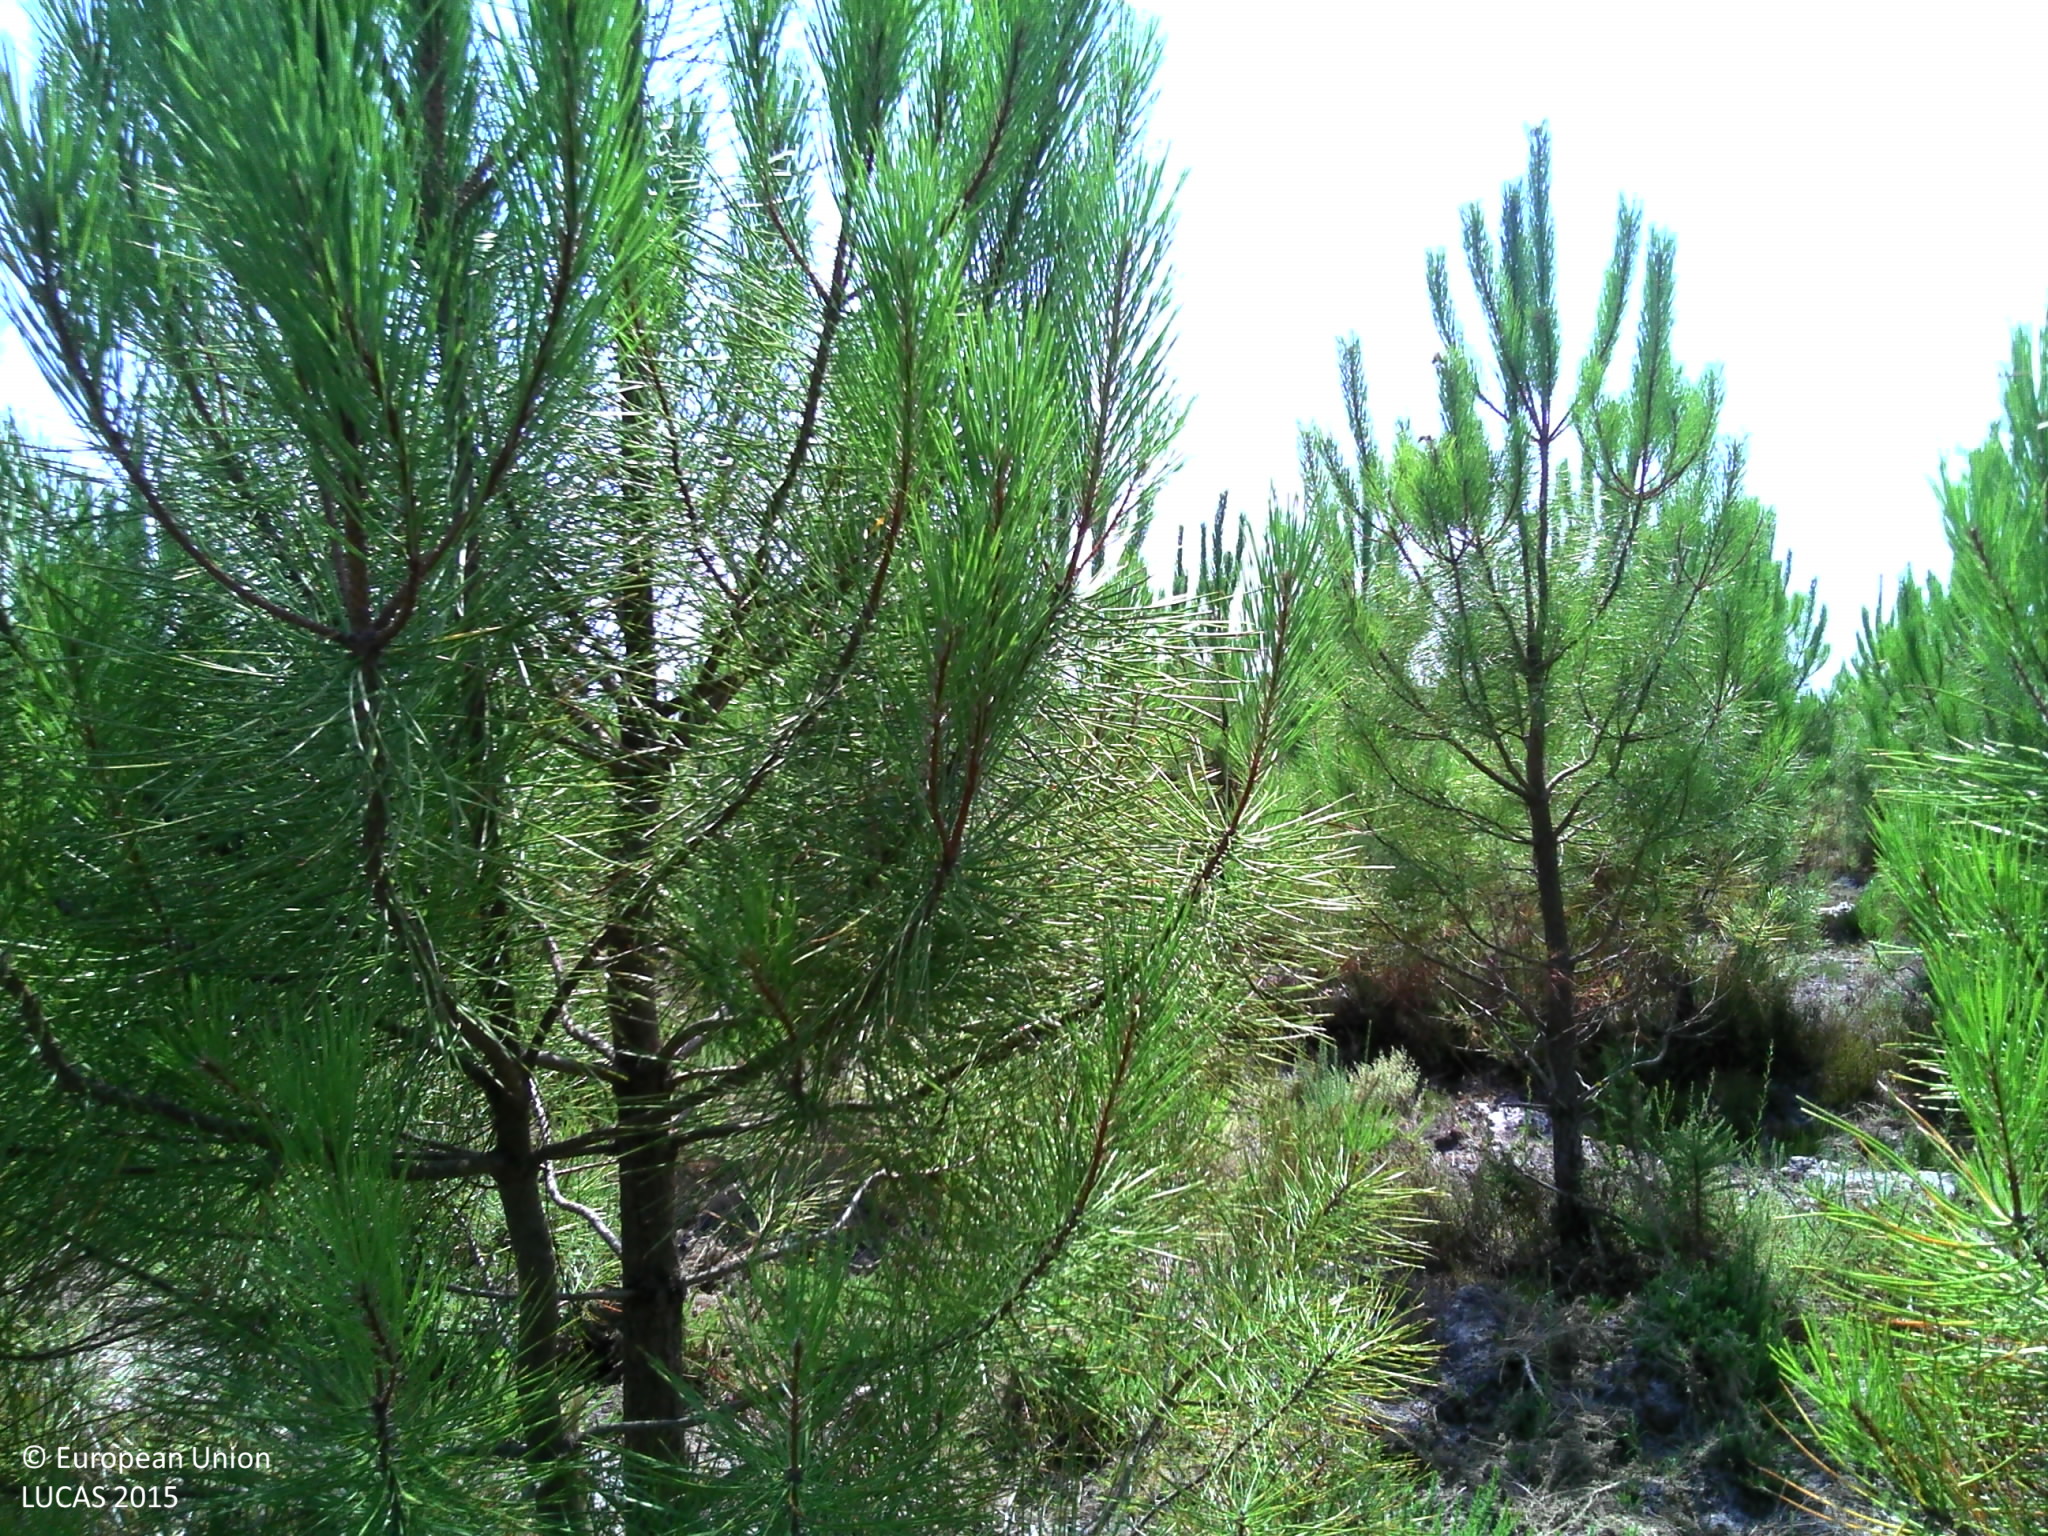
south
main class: Woodland
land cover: Pine dominated coniferous woodland
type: coniferous forest of the mediterranean region
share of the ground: 50 - 75 %
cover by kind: coniferous forest trees 70 %, unconsolidated bare surface 25 %, shrubs 5 %
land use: Forestry
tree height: < 5 m
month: August
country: FR
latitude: 44.1167
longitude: -1.1024
